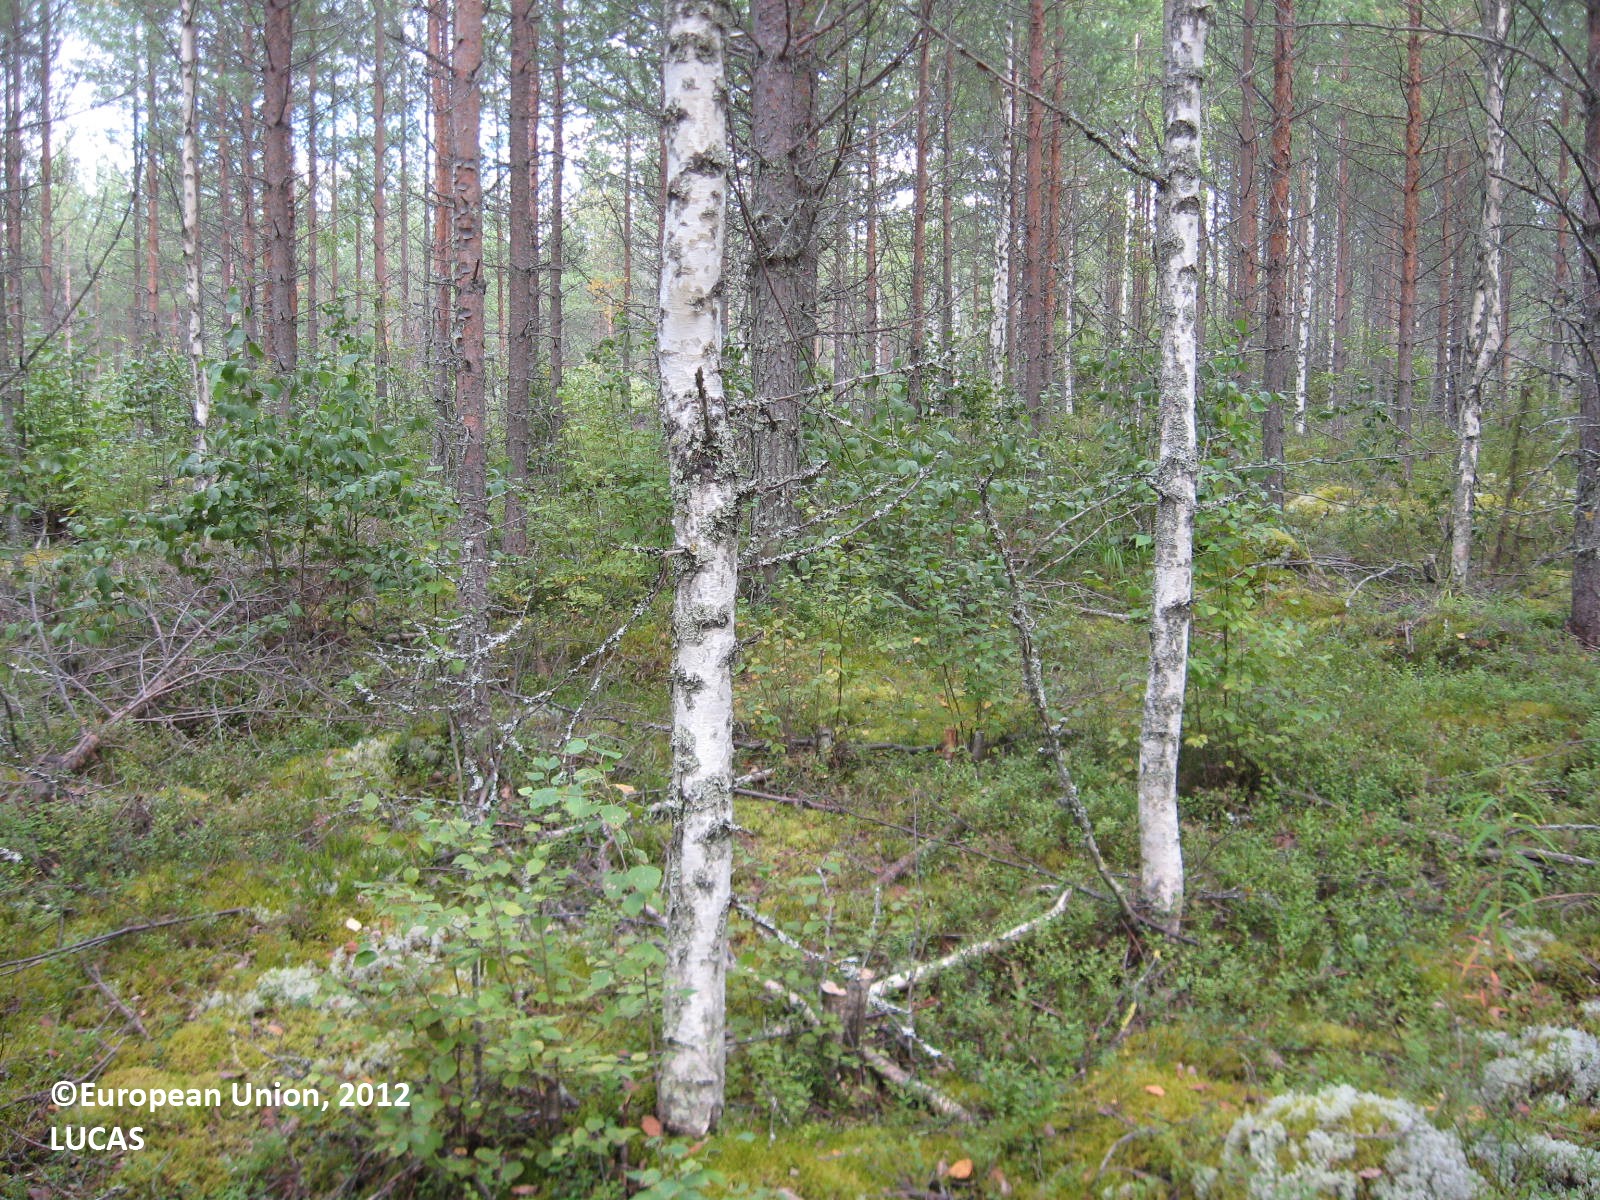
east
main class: Woodland
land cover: Pine dominated mixed woodland
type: boreal forest
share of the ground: > 75 %
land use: Forestry
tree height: > 5 m
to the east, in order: Pine dominated mixed woodland; Ditches and canals; Paved roads, cycling and walking lanes; Ditches and canals; Pine dominated coniferous woodland; Other mixed woodland
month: August
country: FI
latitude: 63.3924
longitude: 30.2110
